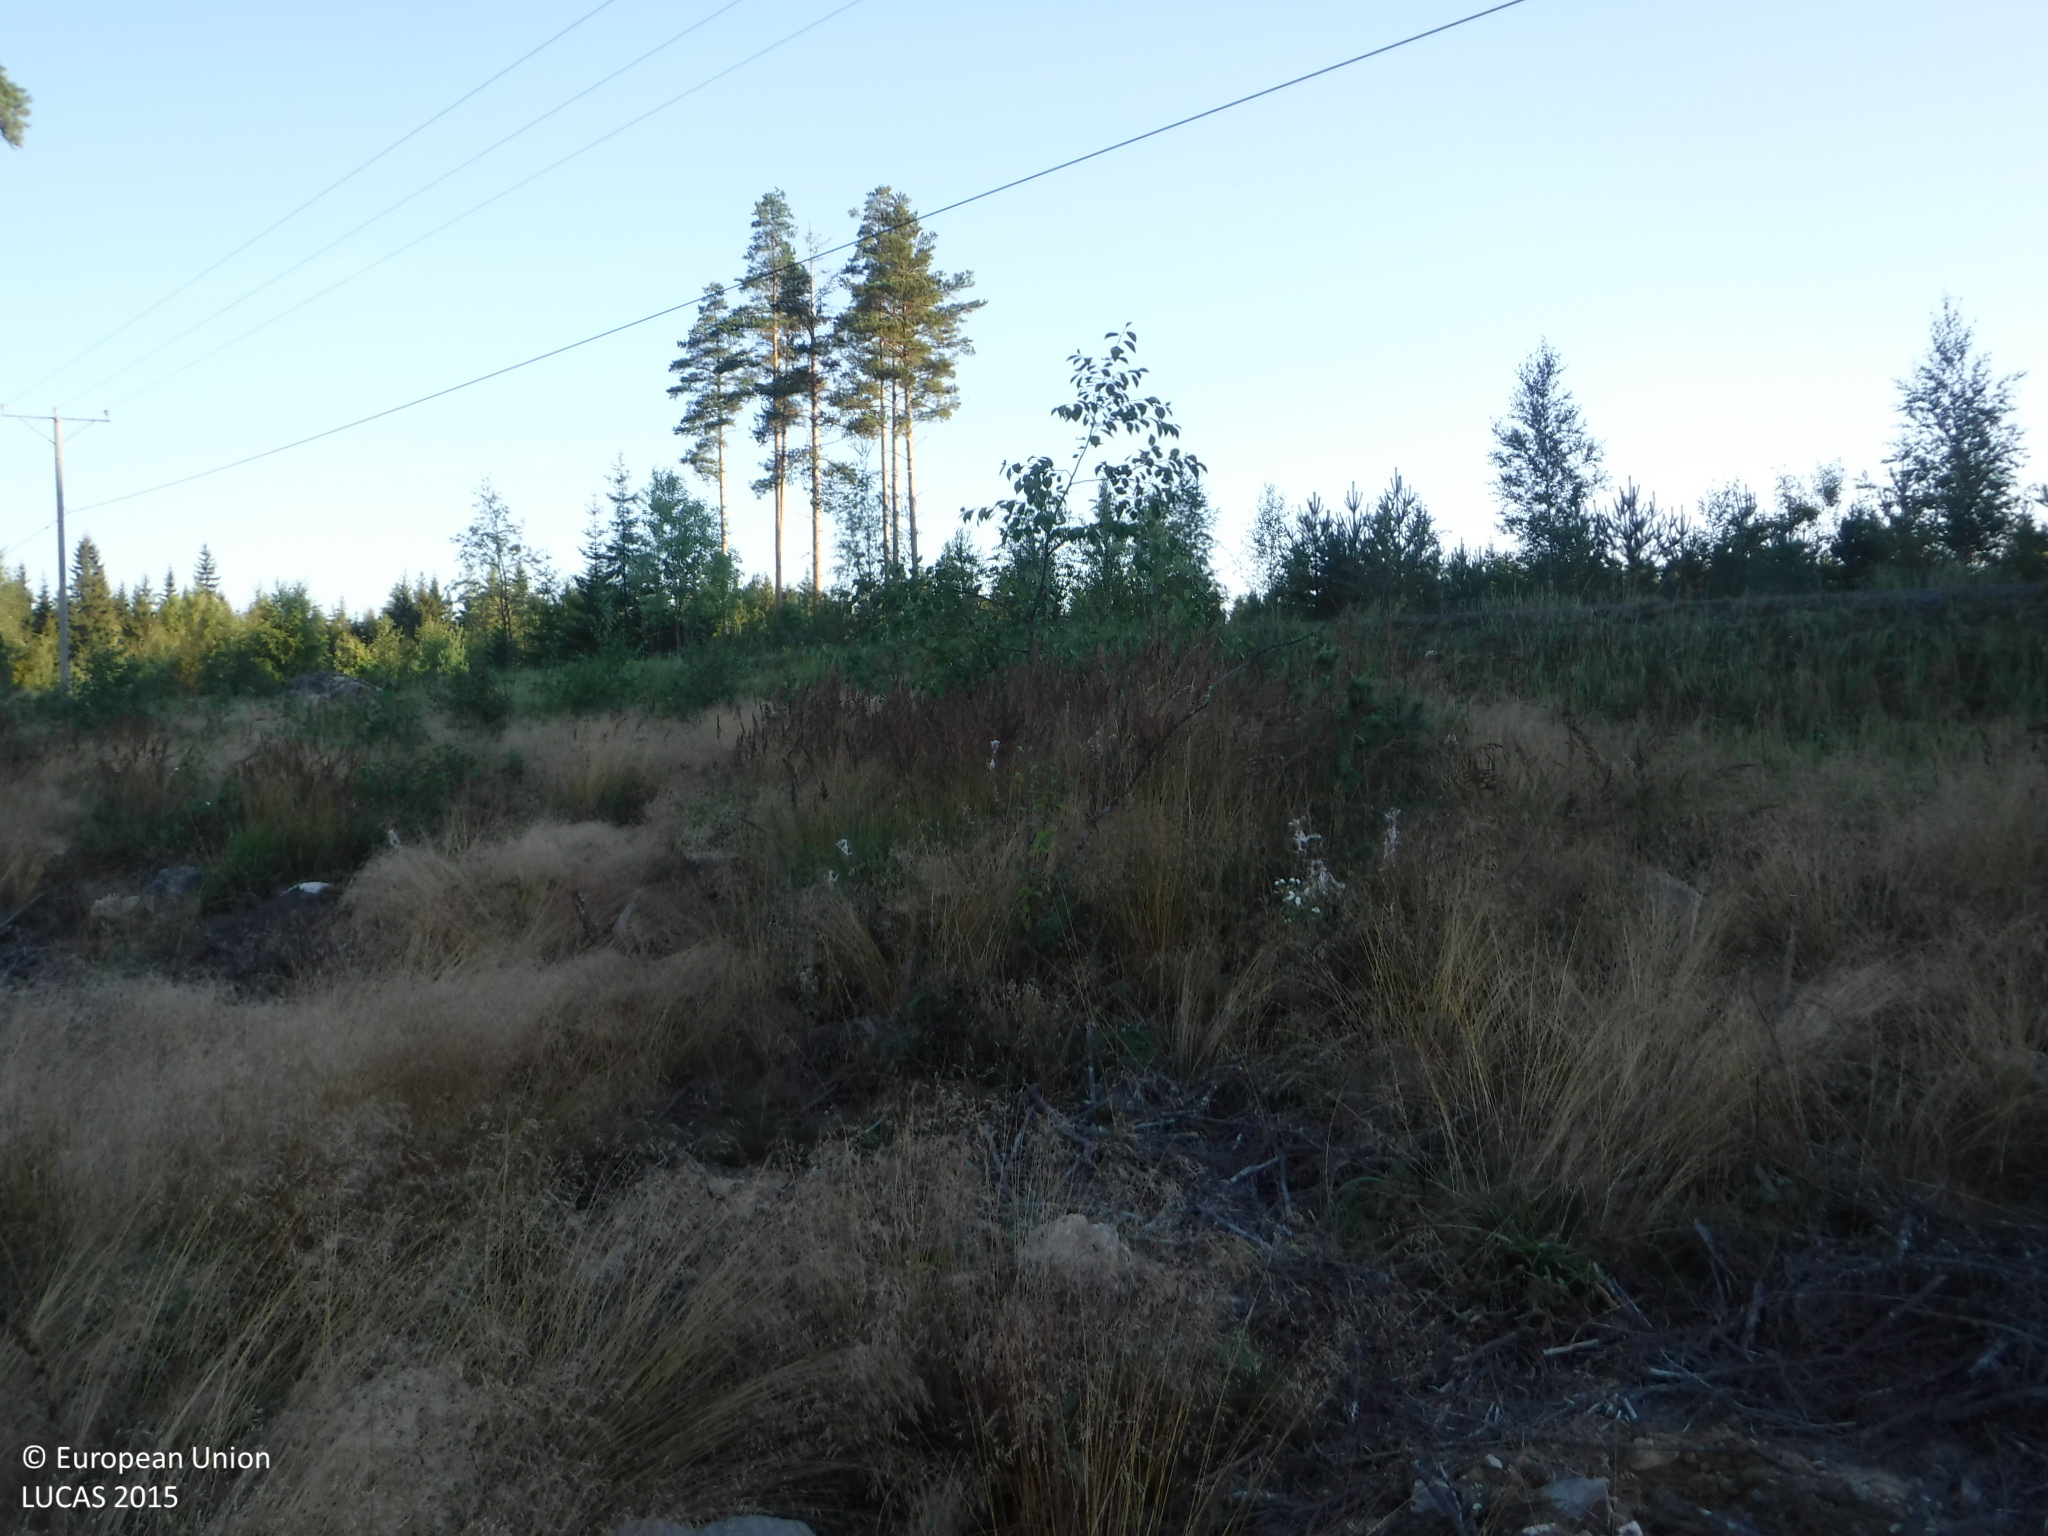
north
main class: Grassland
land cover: Spontaneously vegetated surfaces
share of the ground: 50 - 75 %
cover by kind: herbaceous plants 70 %, unconsolidated bare surface 25 %, consolidated bare surface 5 %
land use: Forestry
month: September
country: FI
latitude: 61.7110
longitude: 22.6424
